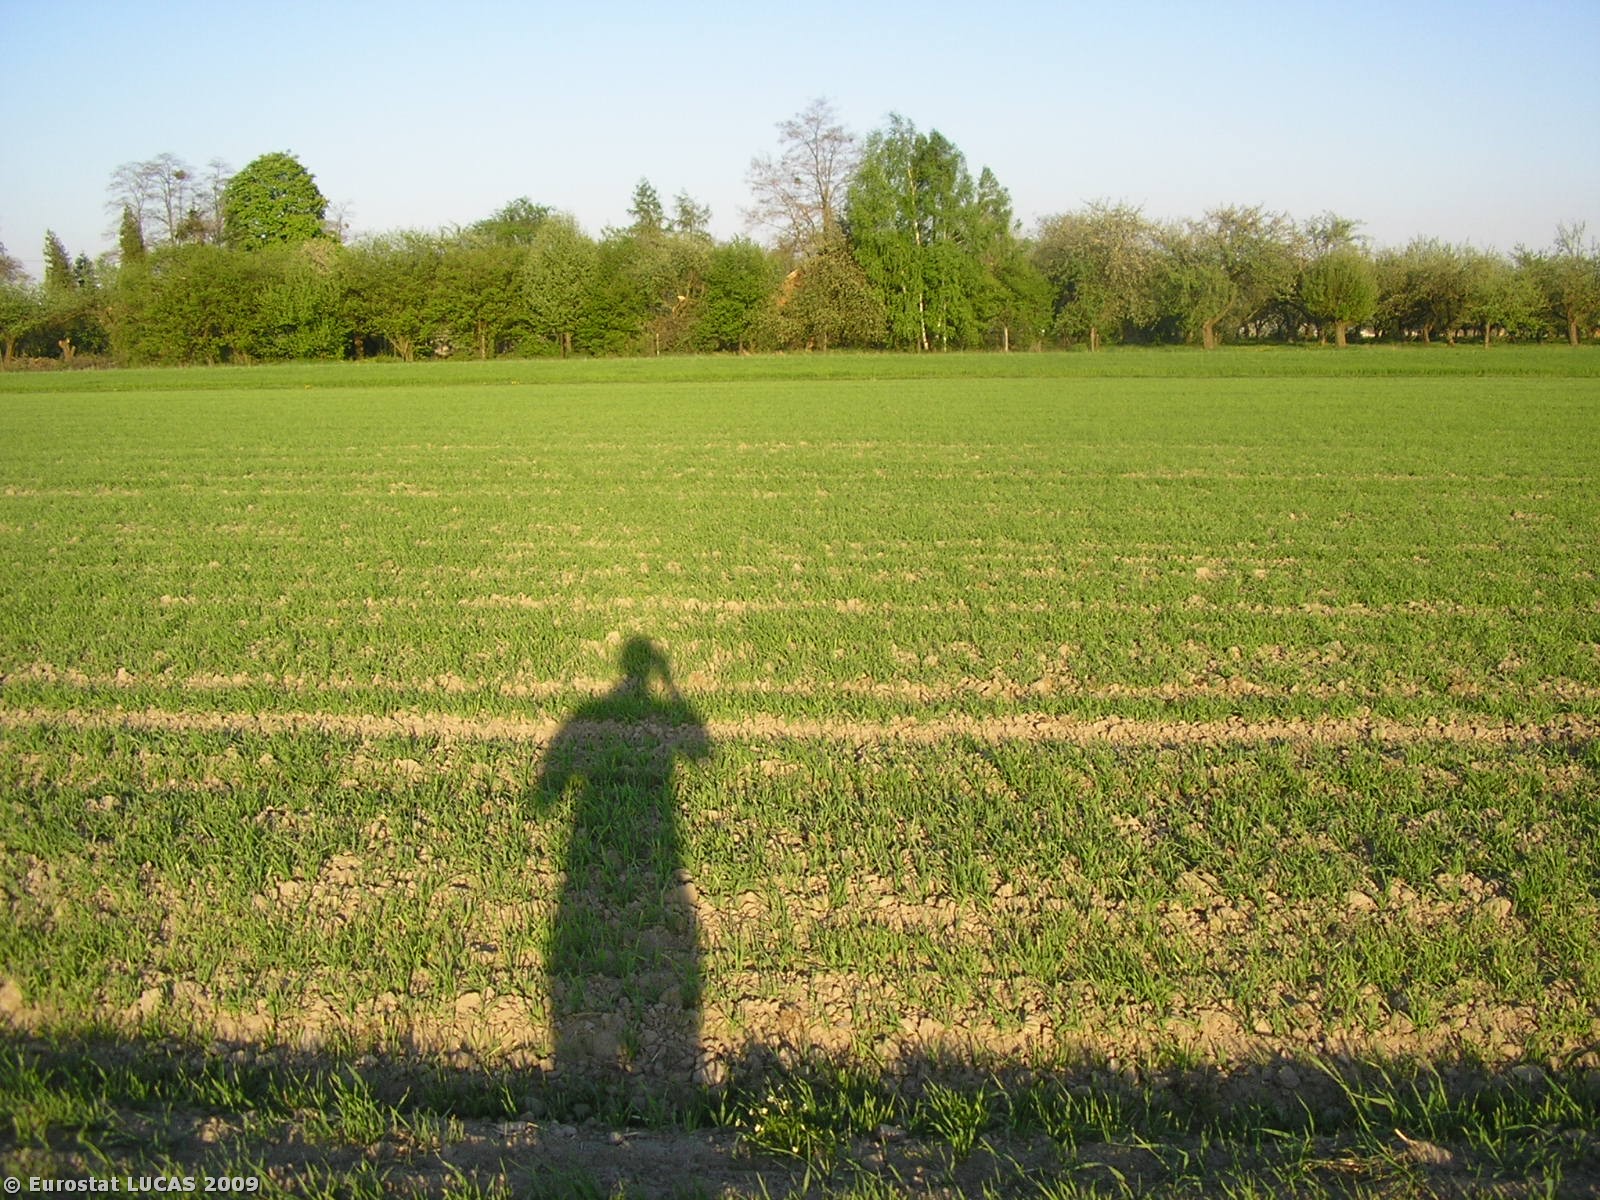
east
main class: Cropland
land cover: Mixed cereals for fodder
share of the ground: 25 - 50 %
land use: Agriculture (excluding fallow land and kitchen gardens)
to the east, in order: Mixed cereals for fodder; Paved roads, cycling and walking lanes; Barley; Fences; Broadleaved woodland; Artificial constructions in urban areas; Apple fruit; Fences; Artificial constructions in urban areas; Fences; Grassland with sparse tree/shrub cover; Grassland without tree/shrub cover; Lines of trees; Paved roads, cycling and walking lanes; Grassland without tree/shrub cover; Mixed cereals for fodder
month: April
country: PL
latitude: 52.2336
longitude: 20.1225
